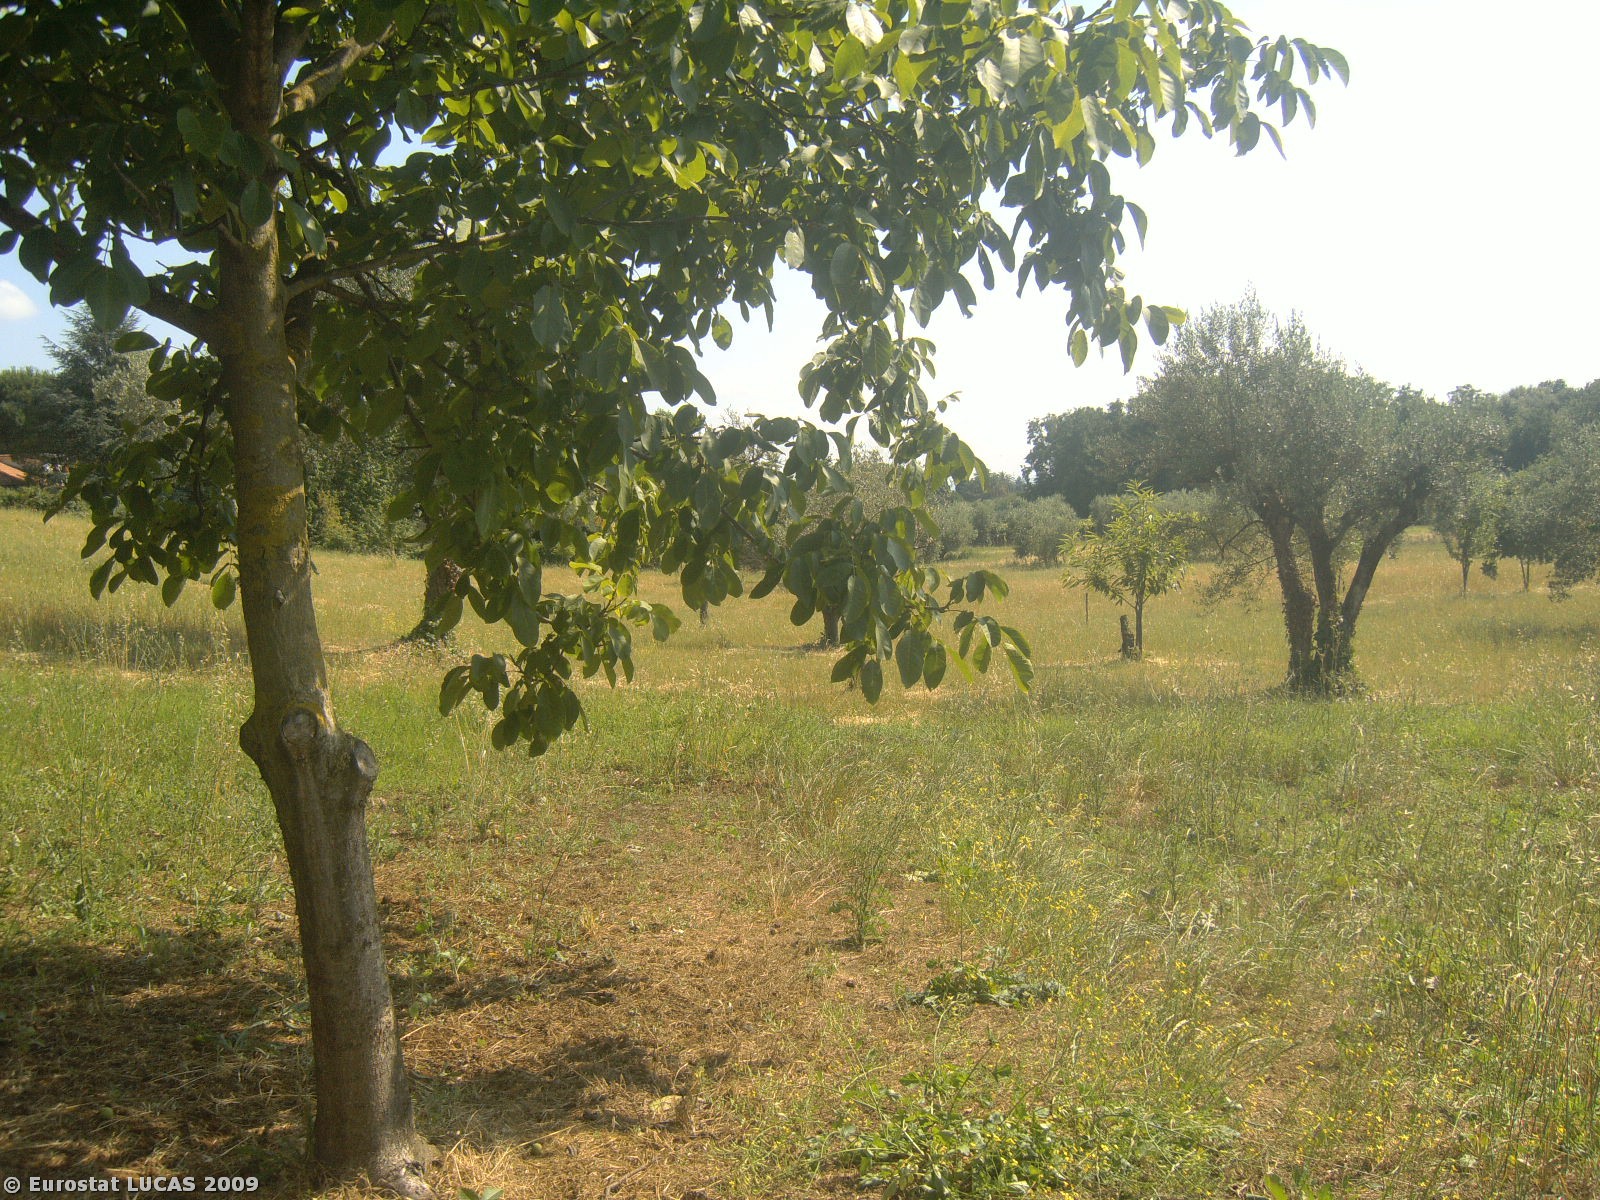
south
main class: Cropland
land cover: Nuts trees
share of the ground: 25 - 50 %
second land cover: Olive groves
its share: 25 - 50 %
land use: Agriculture (excluding fallow land and kitchen gardens)
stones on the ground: < 10 %
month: June
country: IT
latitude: 41.6769
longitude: 12.7402
